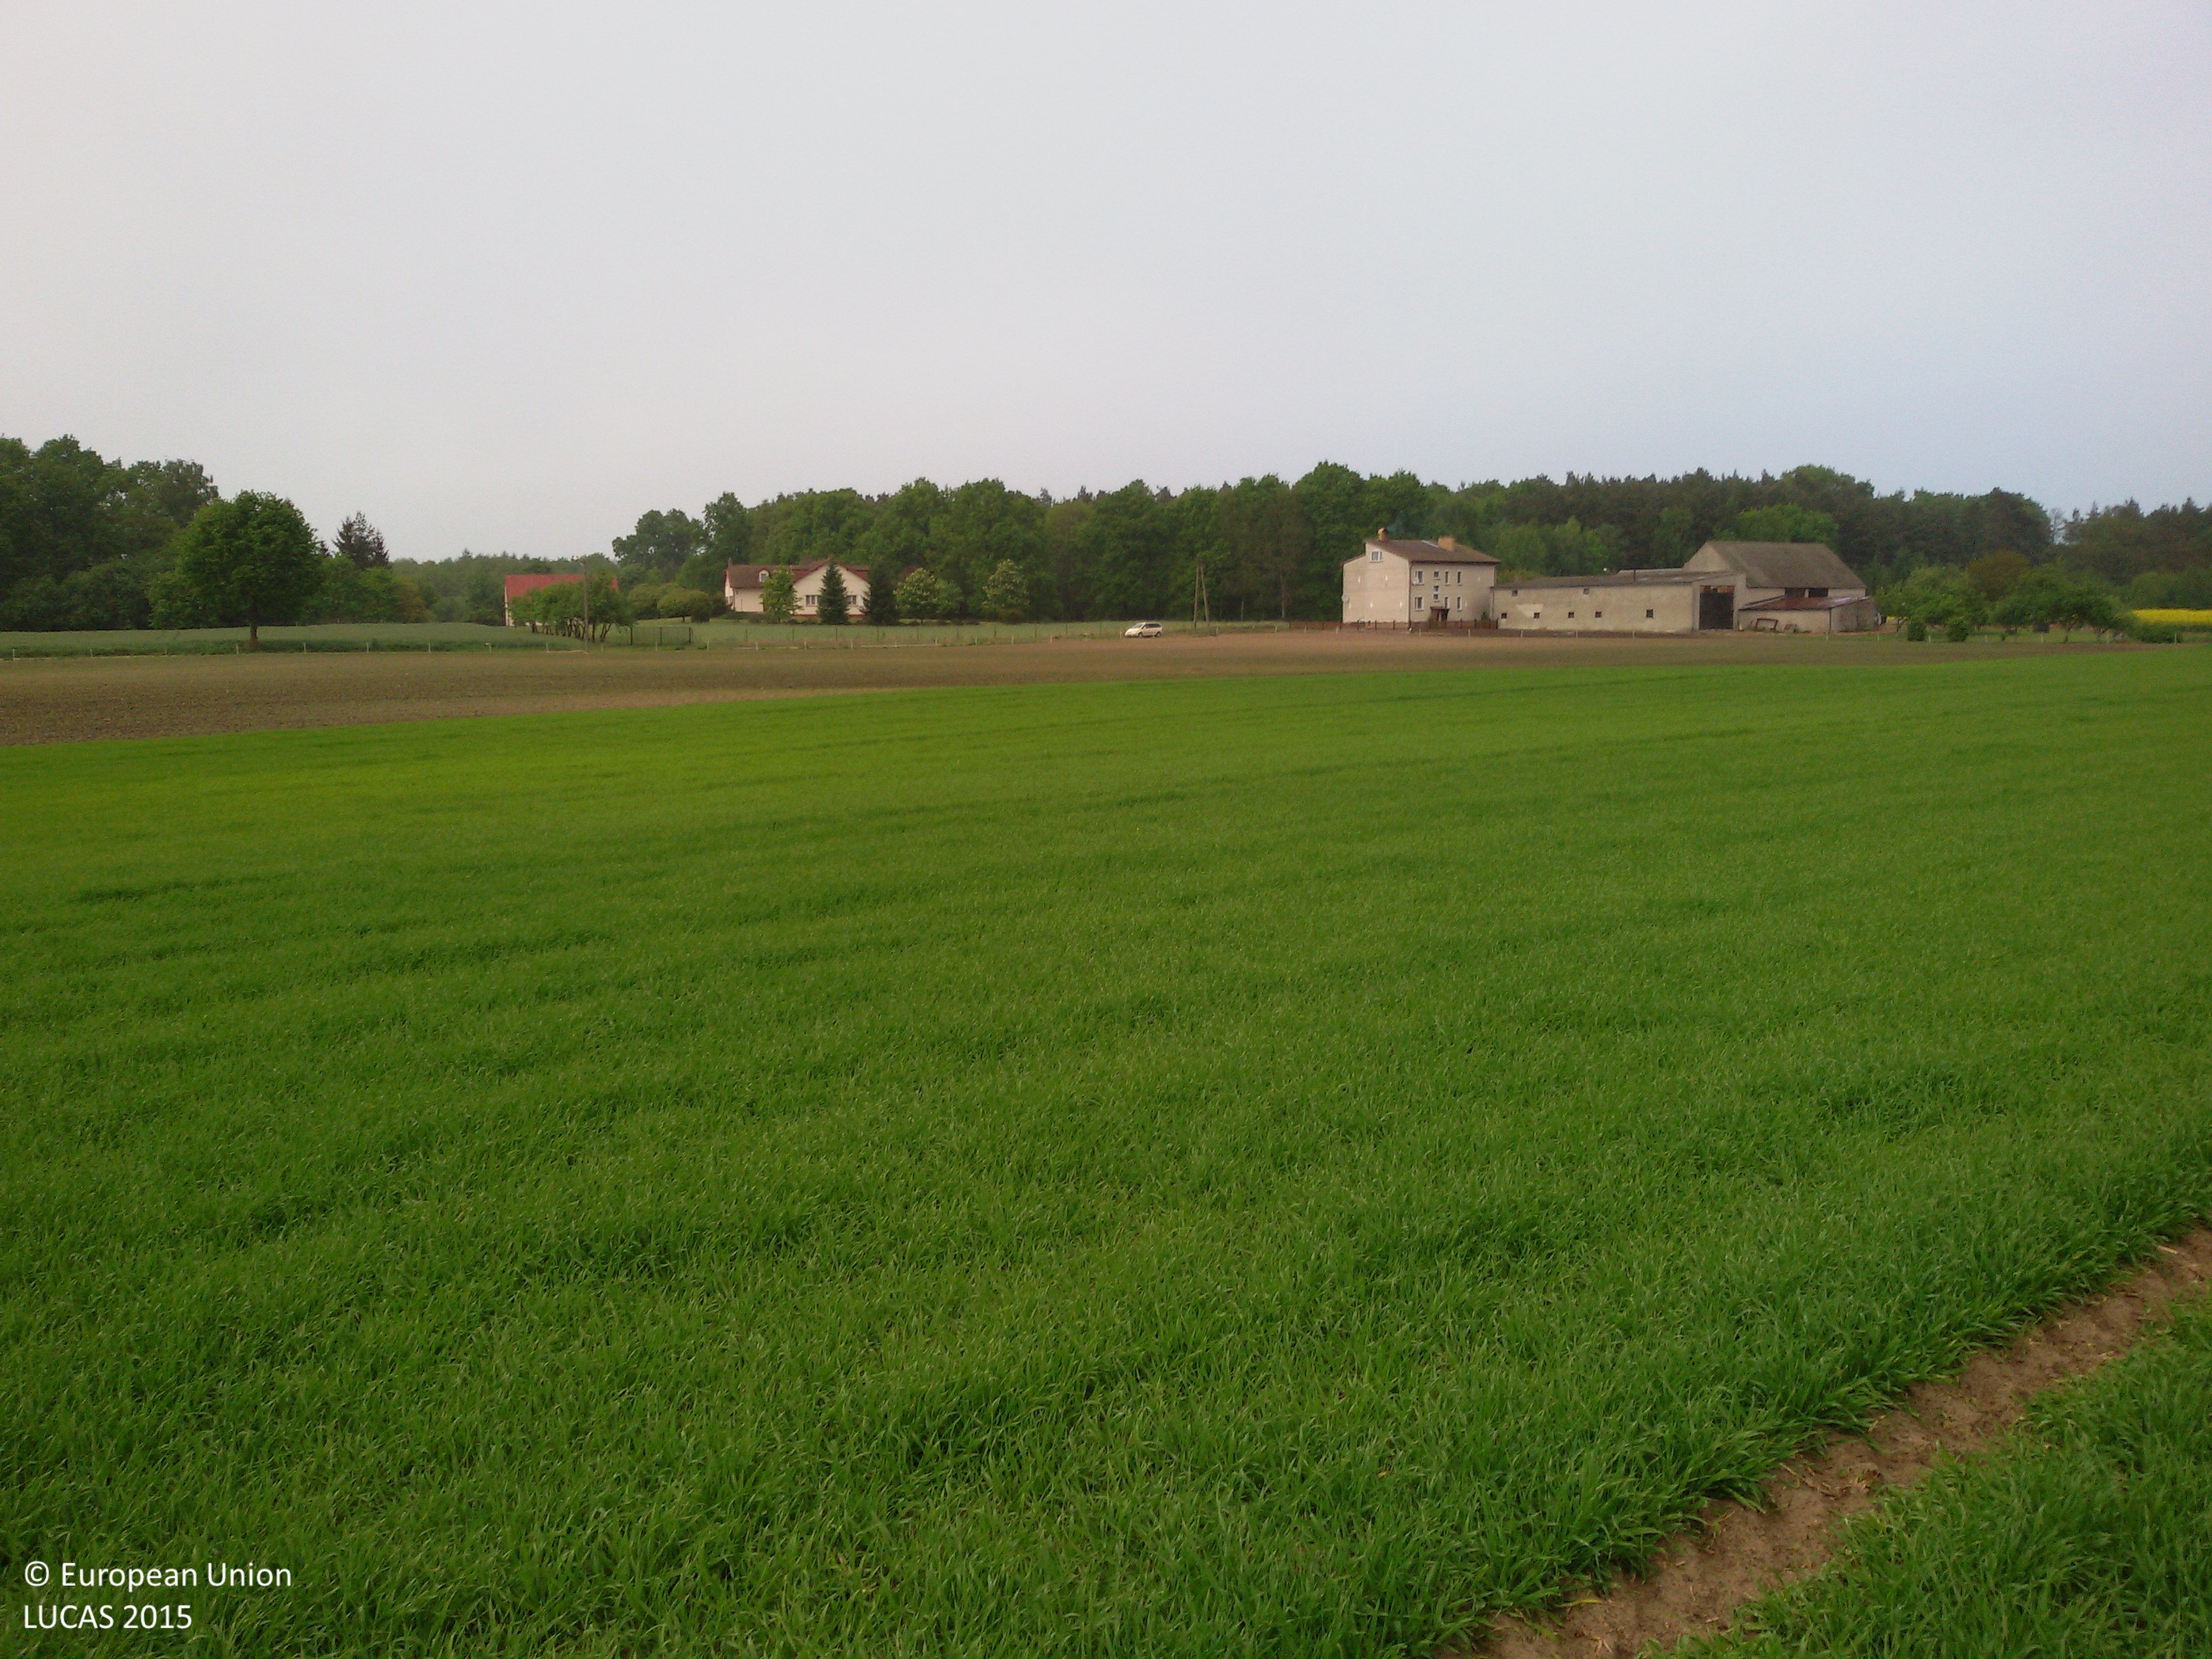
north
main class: Cropland
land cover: Barley
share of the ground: > 75 %
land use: Agriculture (excluding fallow land and kitchen gardens)
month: May
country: PL
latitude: 52.9351
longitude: 17.1967
